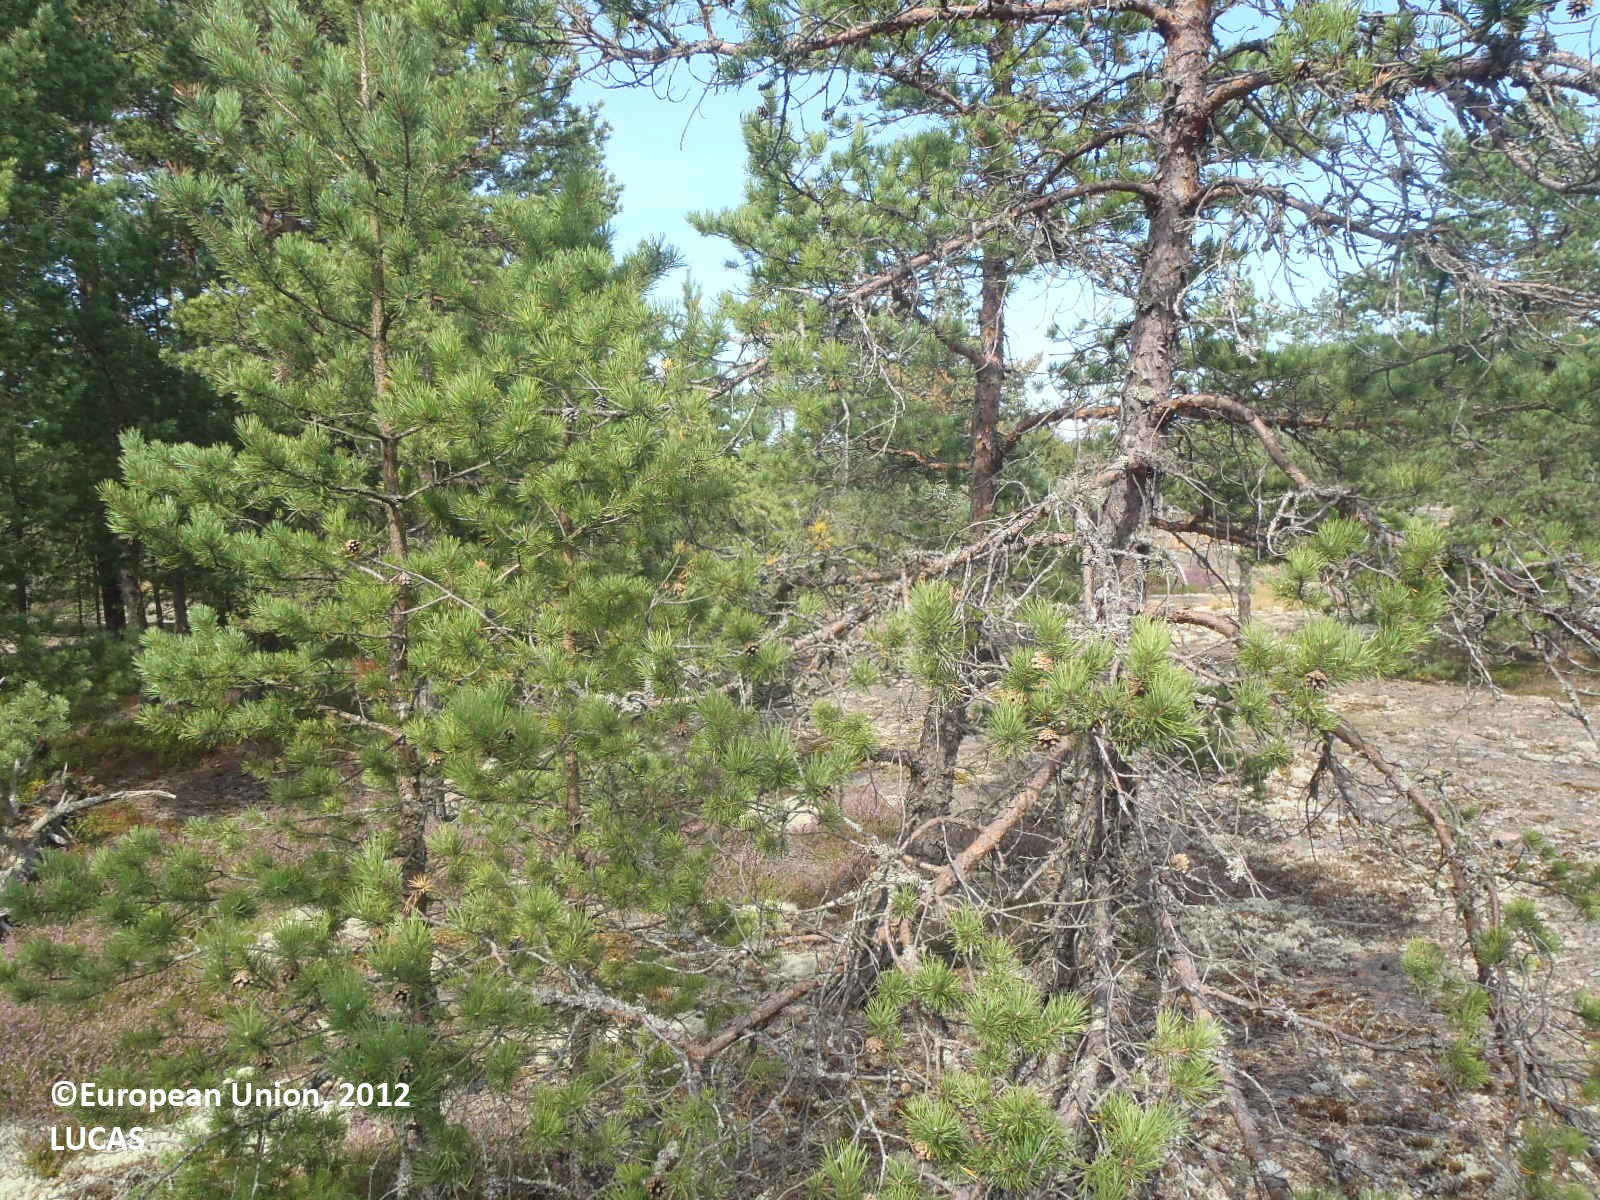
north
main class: Woodland
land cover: Pine dominated coniferous woodland
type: boreal forest
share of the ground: 10 - 25 %
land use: Forestry
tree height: > 5 m
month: August
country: FI
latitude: 60.2555
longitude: 20.0719
